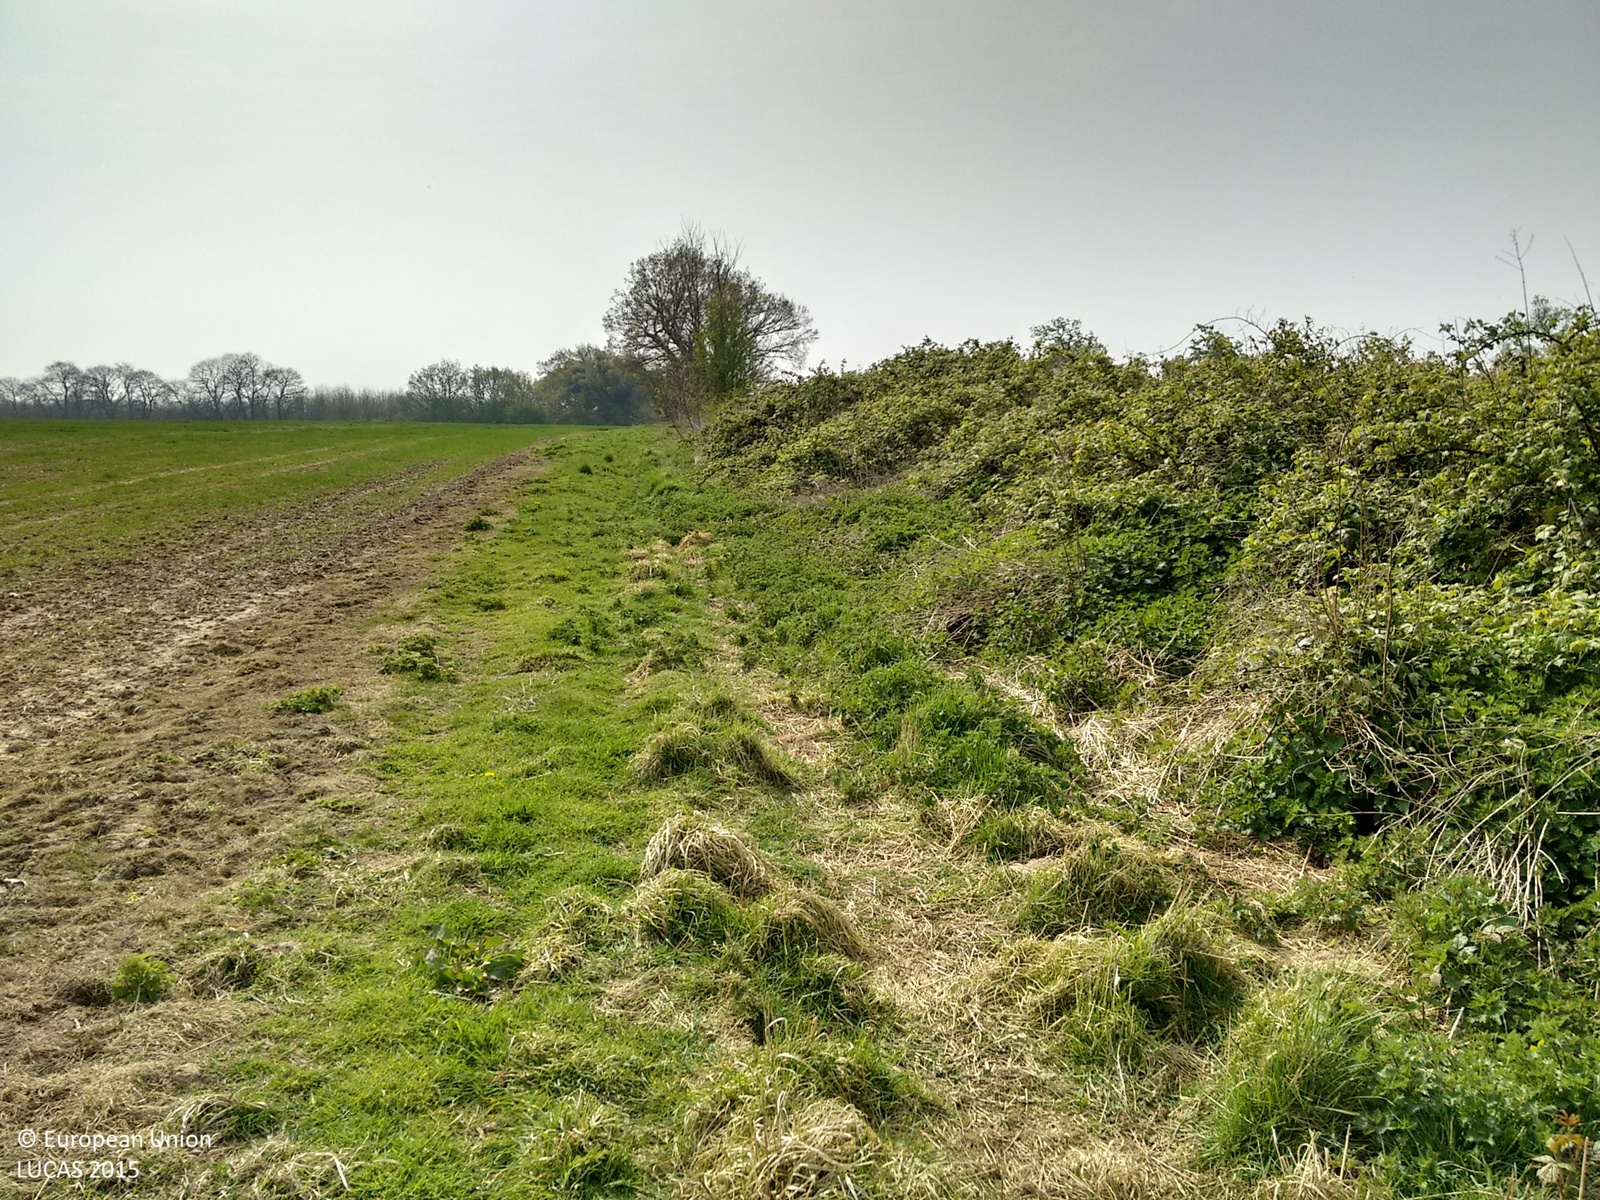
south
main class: Cropland
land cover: Common wheat
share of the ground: 25 - 50 %
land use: Agriculture (excluding fallow land and kitchen gardens)
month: April
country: GB
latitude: 51.3912
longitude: 0.4144
